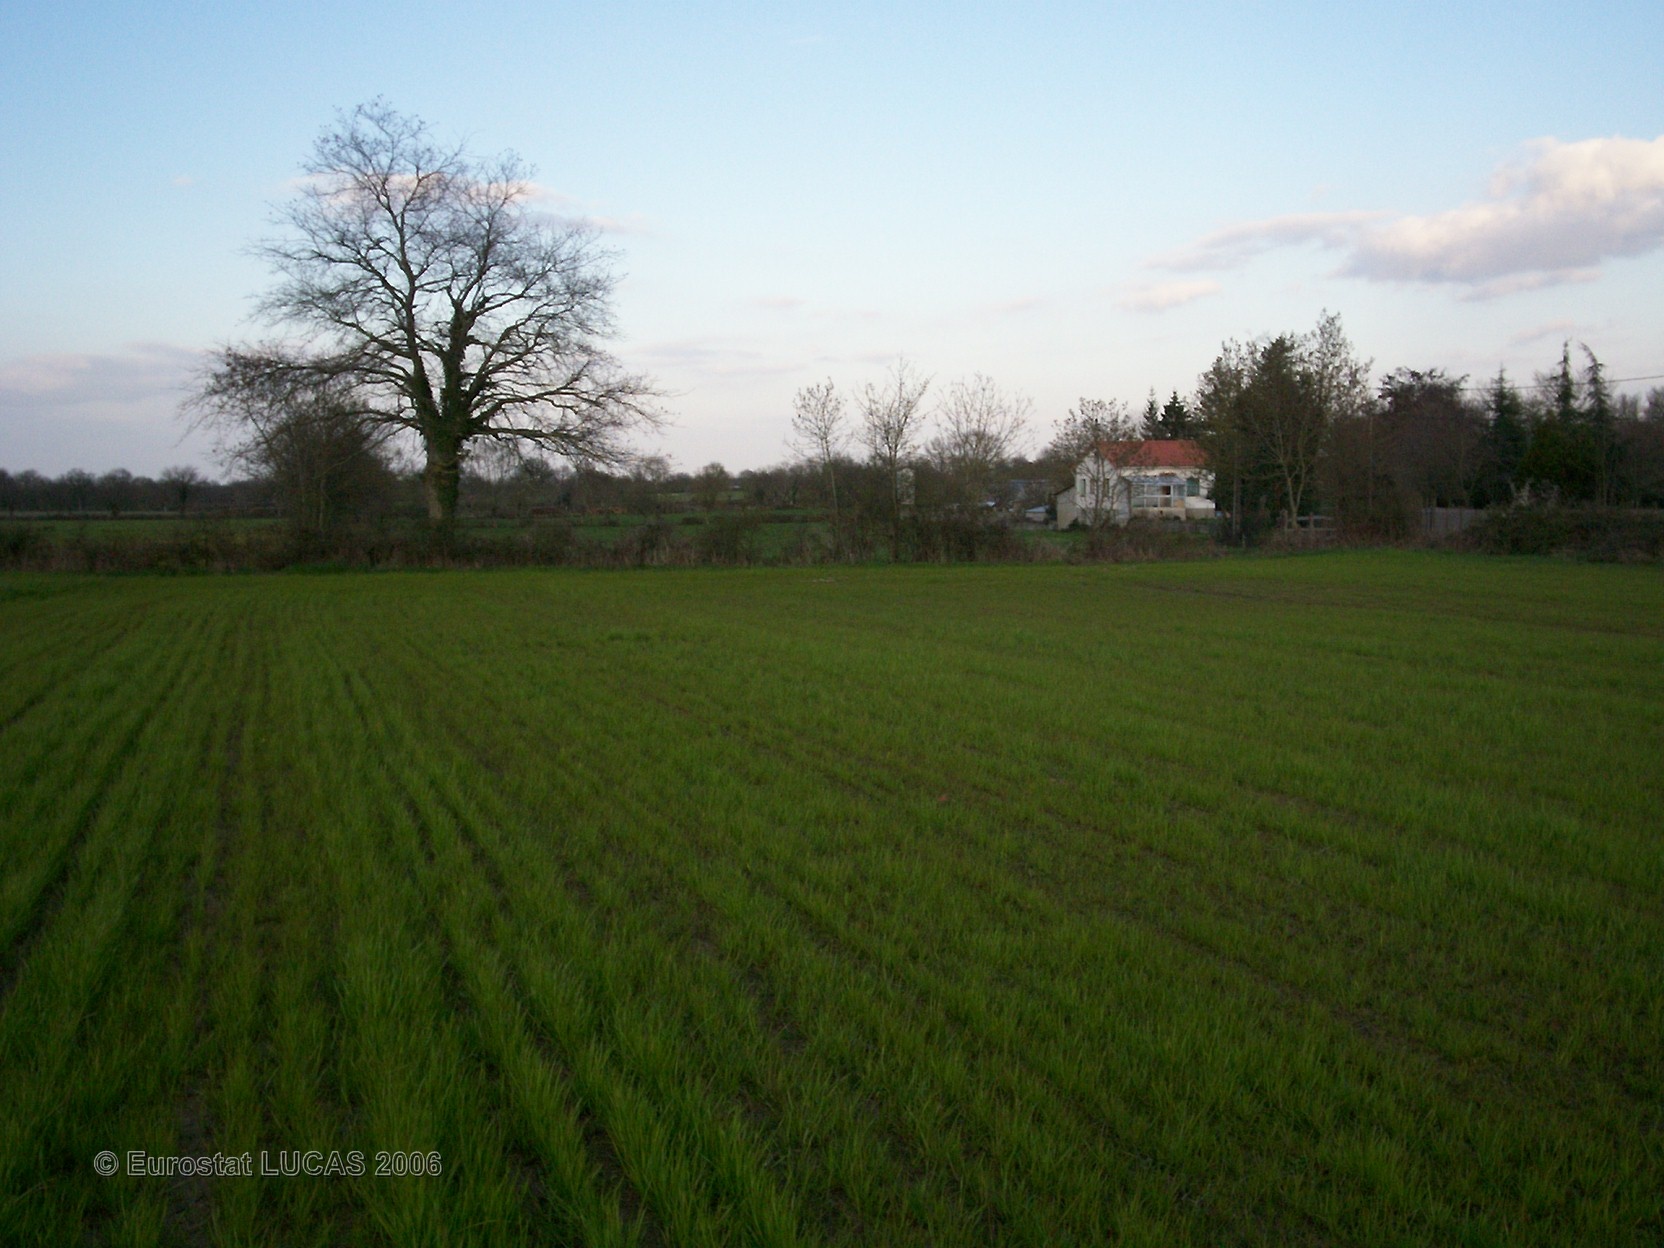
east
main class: Grassland
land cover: Grassland without tree/shrub cover
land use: Agriculture (excluding fallow land and kitchen gardens)
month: April
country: FR
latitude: 46.7598
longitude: -0.3035
